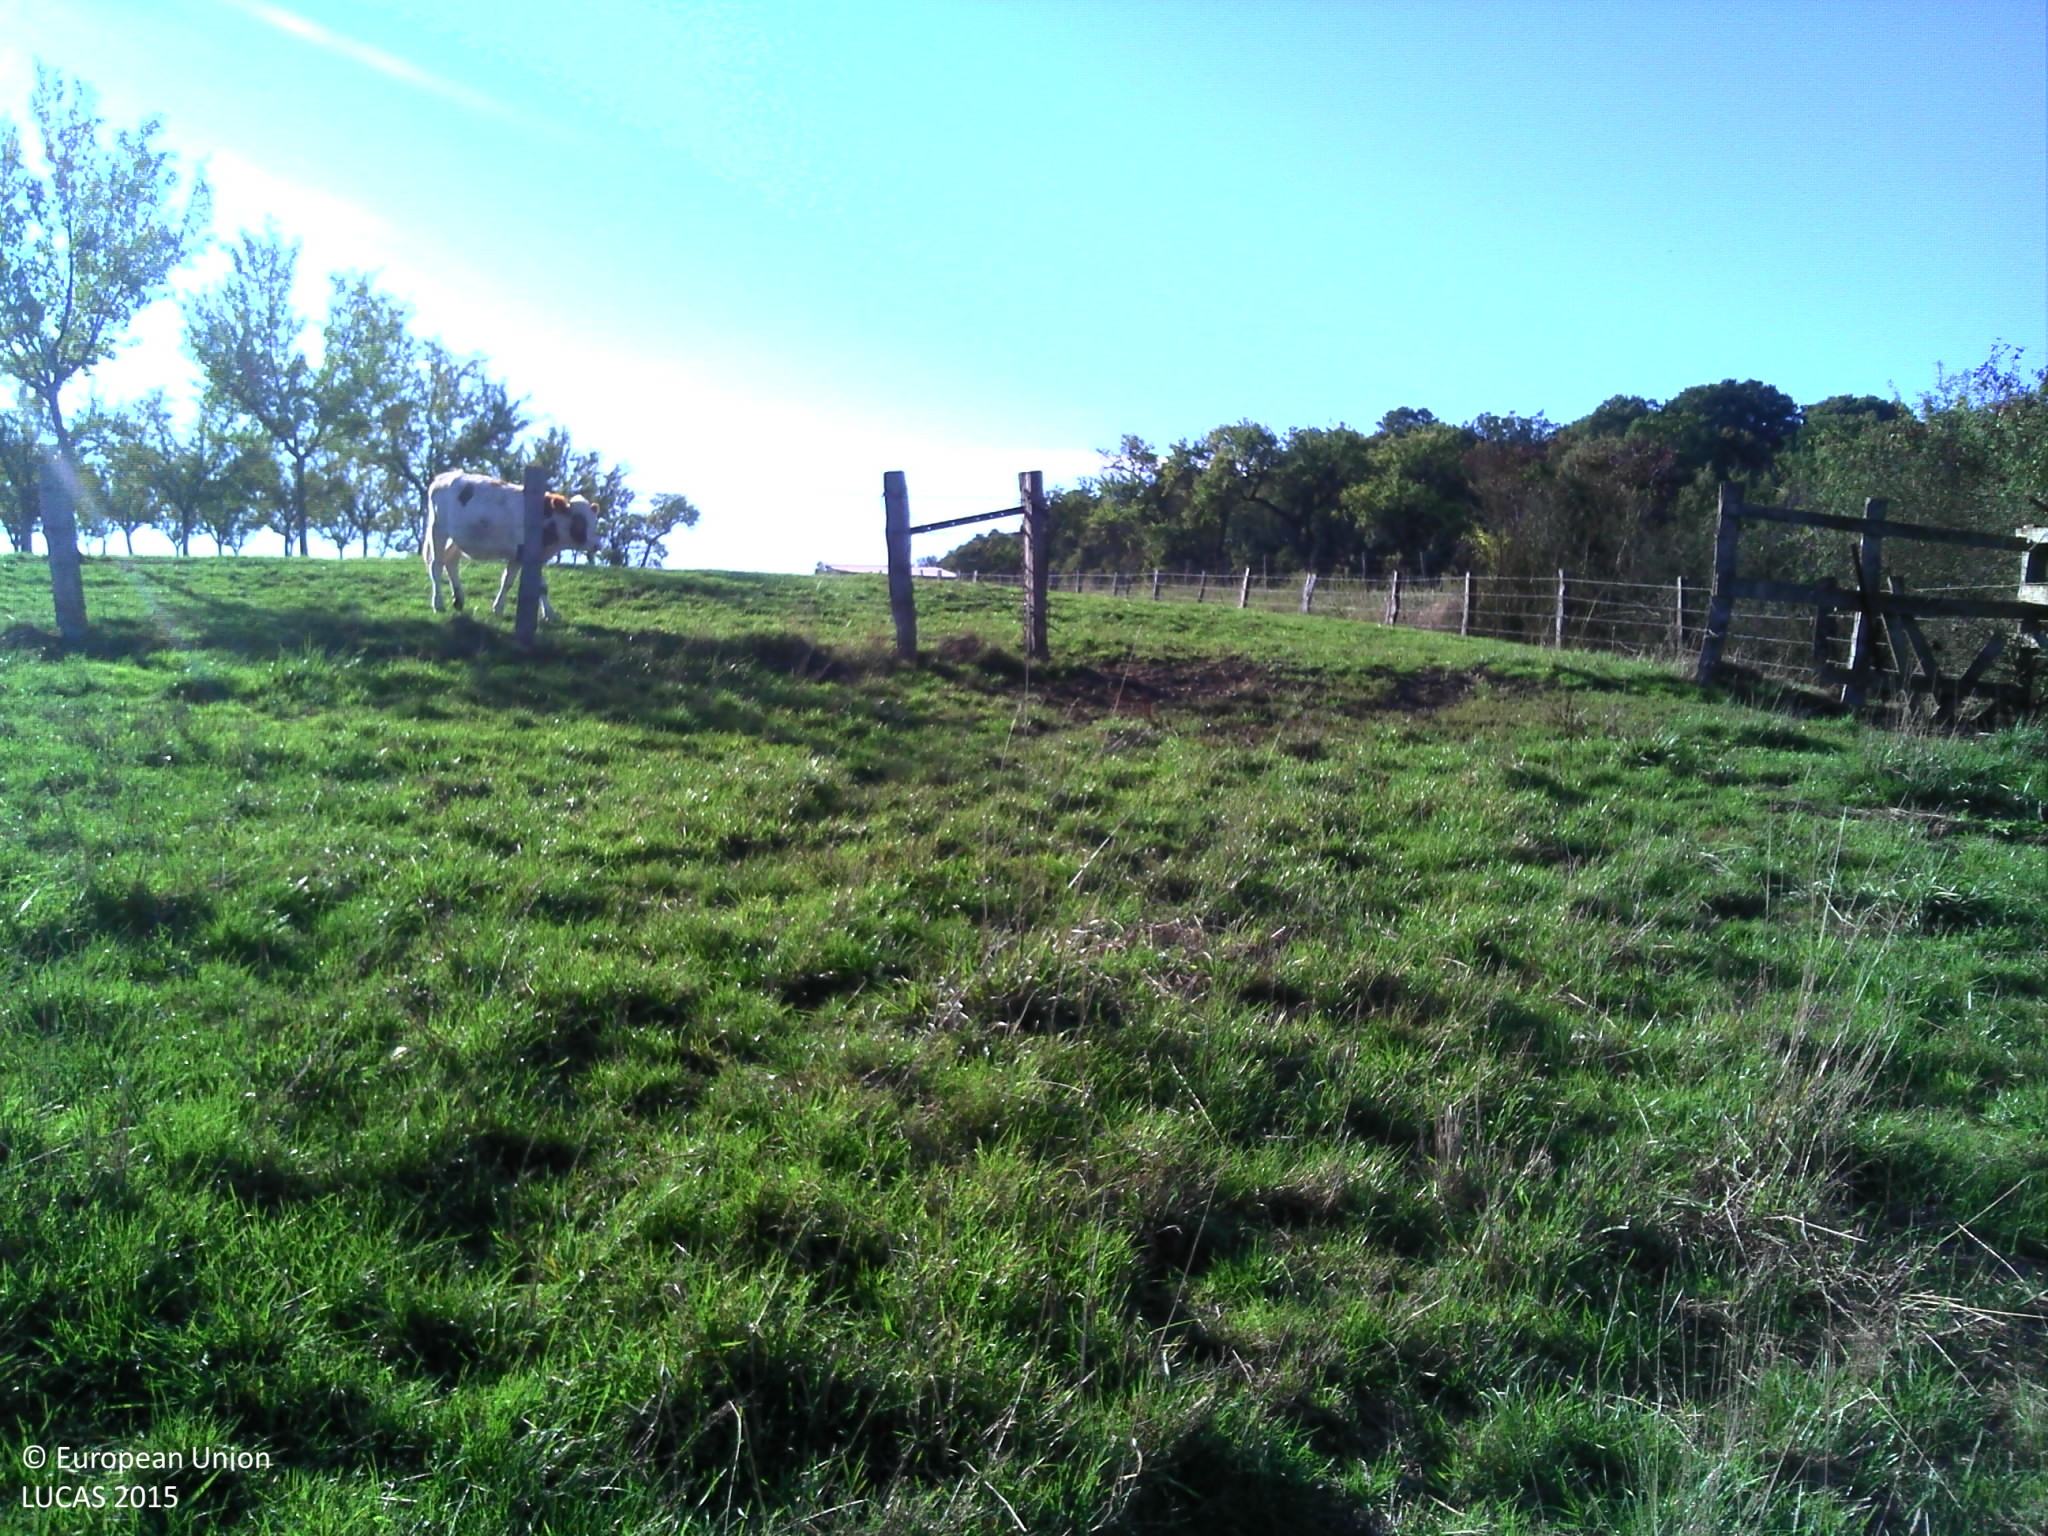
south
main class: Grassland
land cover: Grassland without tree/shrub cover
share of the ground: > 75 %
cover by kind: herbaceous plants 95 %, consolidated bare surface 5 %
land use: Agriculture (excluding fallow land and kitchen gardens)
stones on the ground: < 10 %
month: September
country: FR
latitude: 48.4256
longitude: 6.1217
